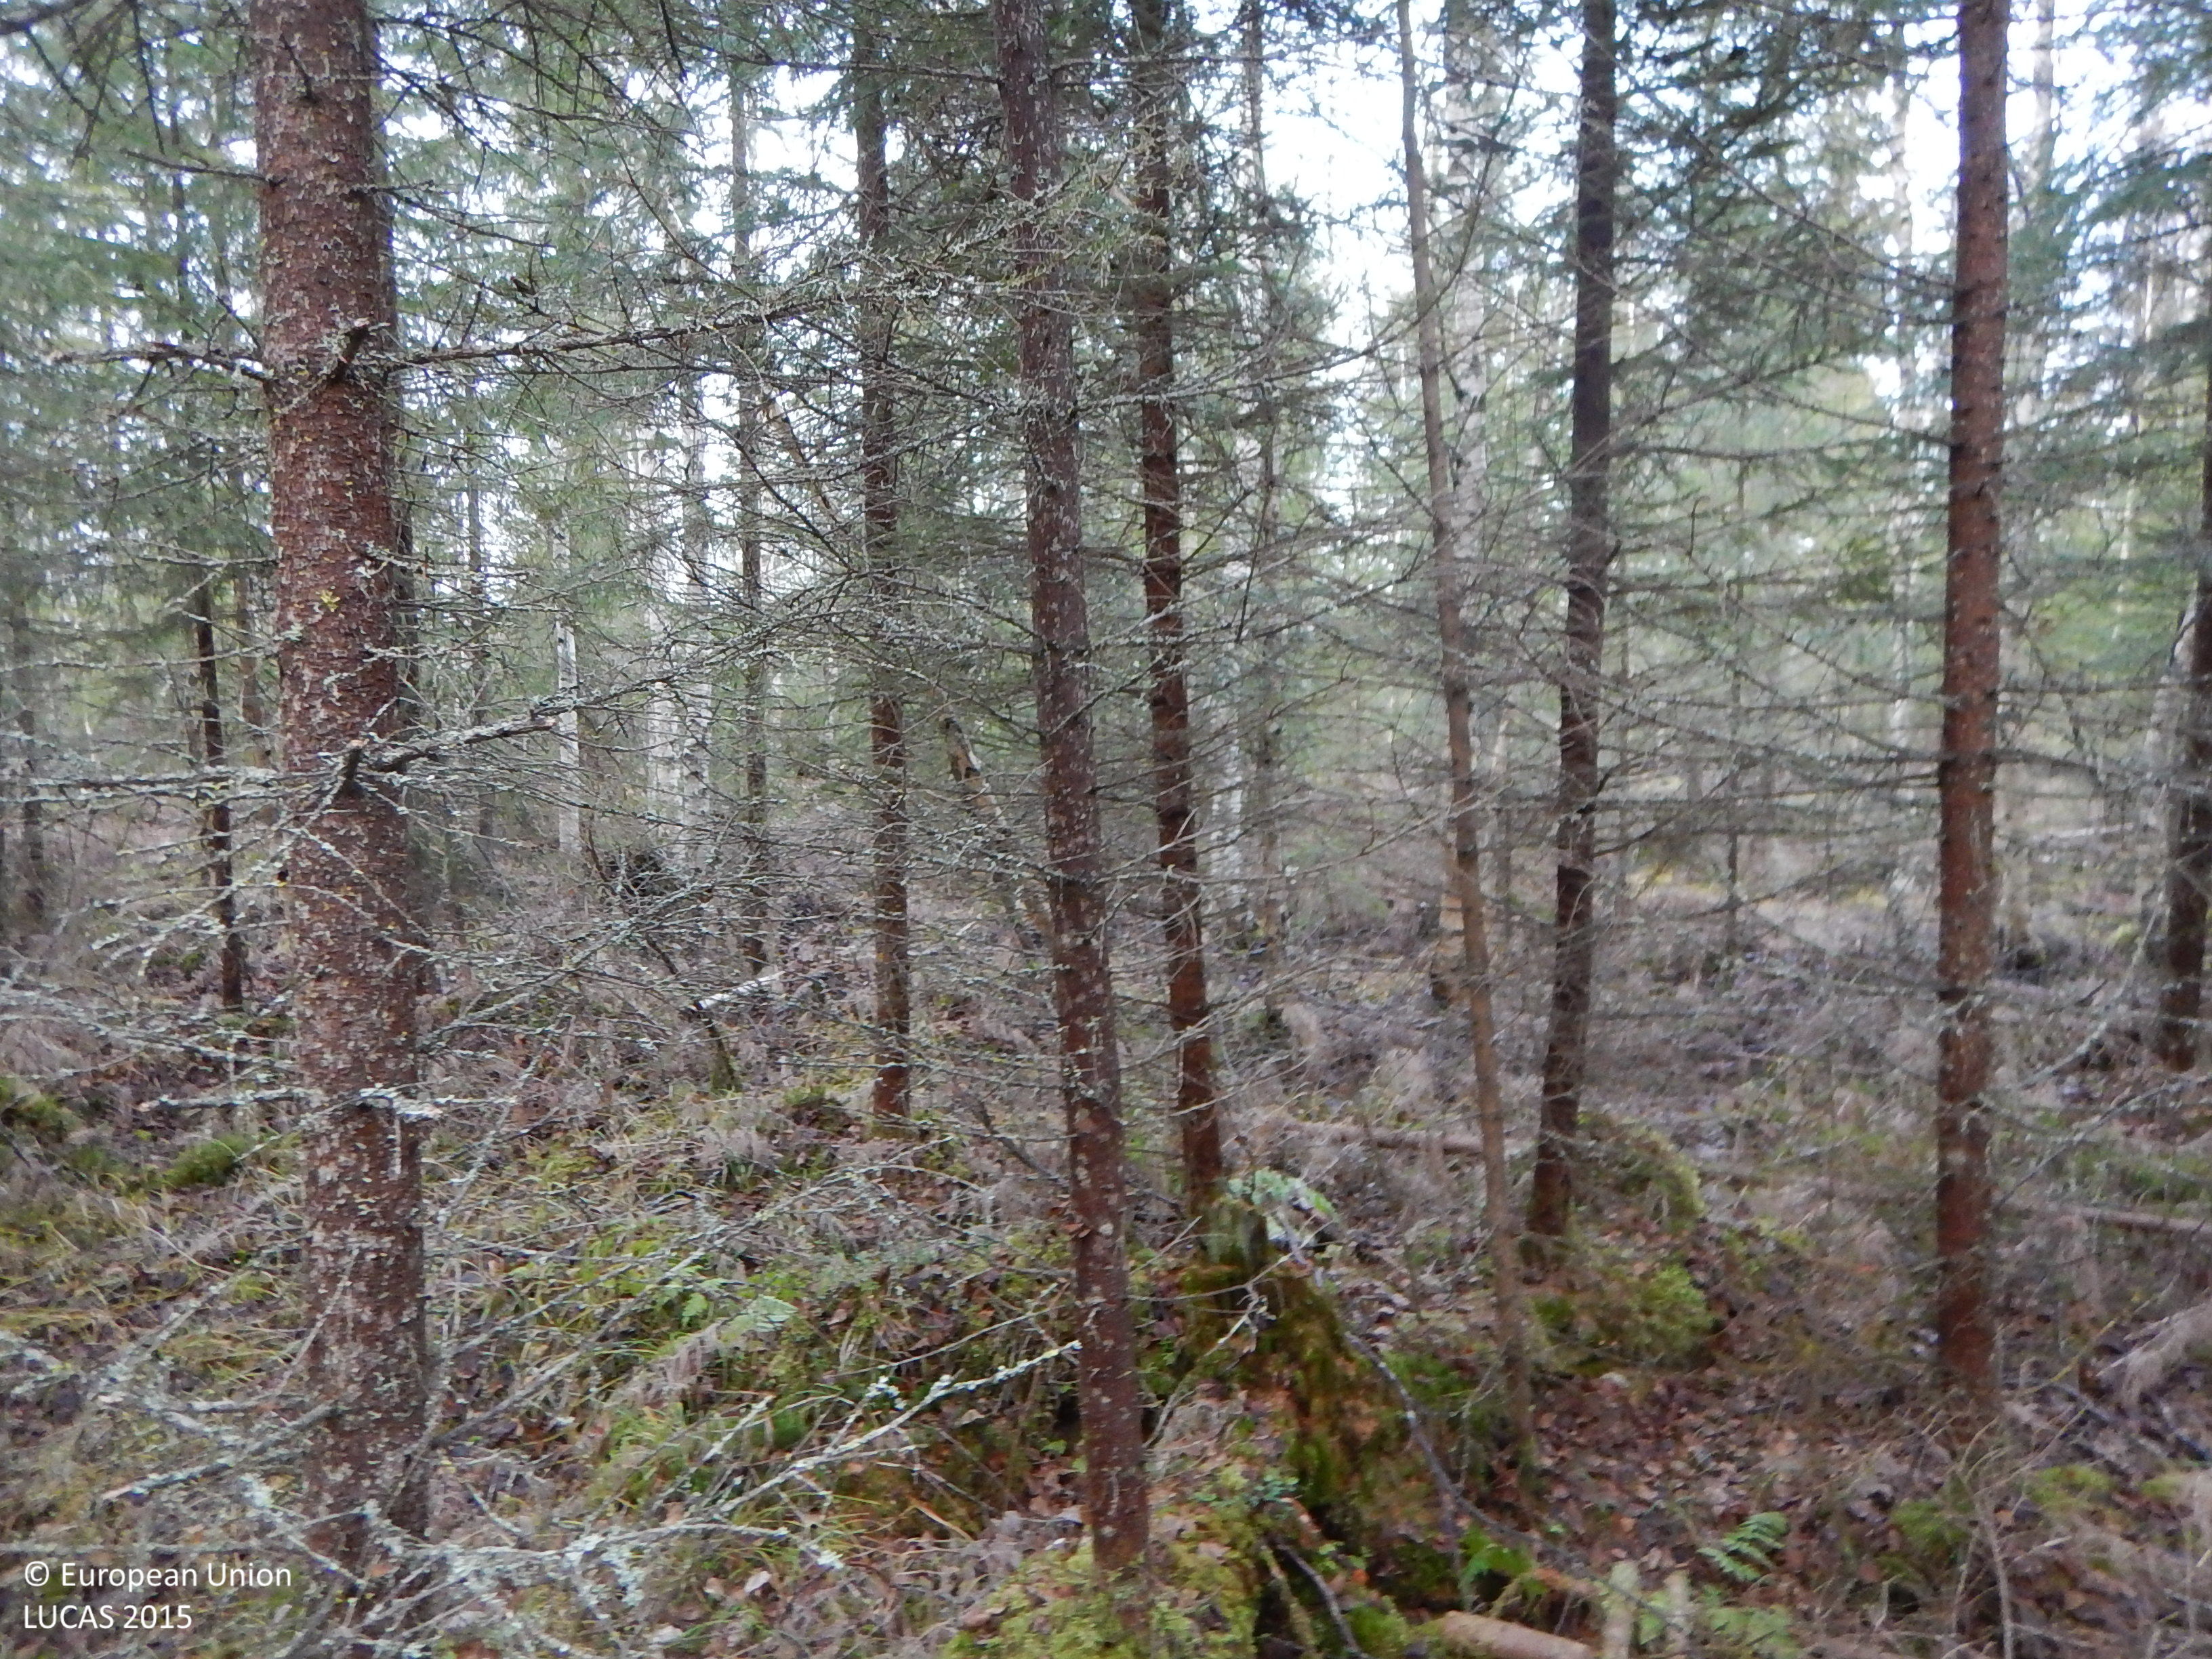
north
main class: Woodland
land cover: Spruce dominated mixed woodland
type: boreal forest
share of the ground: 50 - 75 %
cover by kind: coniferous forest trees 30 %, broadleaved forest trees 30 %, herbaceous plants 20 %, shrubs 10 %, lichens and mosses 10 %
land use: Forestry
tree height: > 5 m
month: October
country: SE
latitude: 65.4063
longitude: 21.2355
